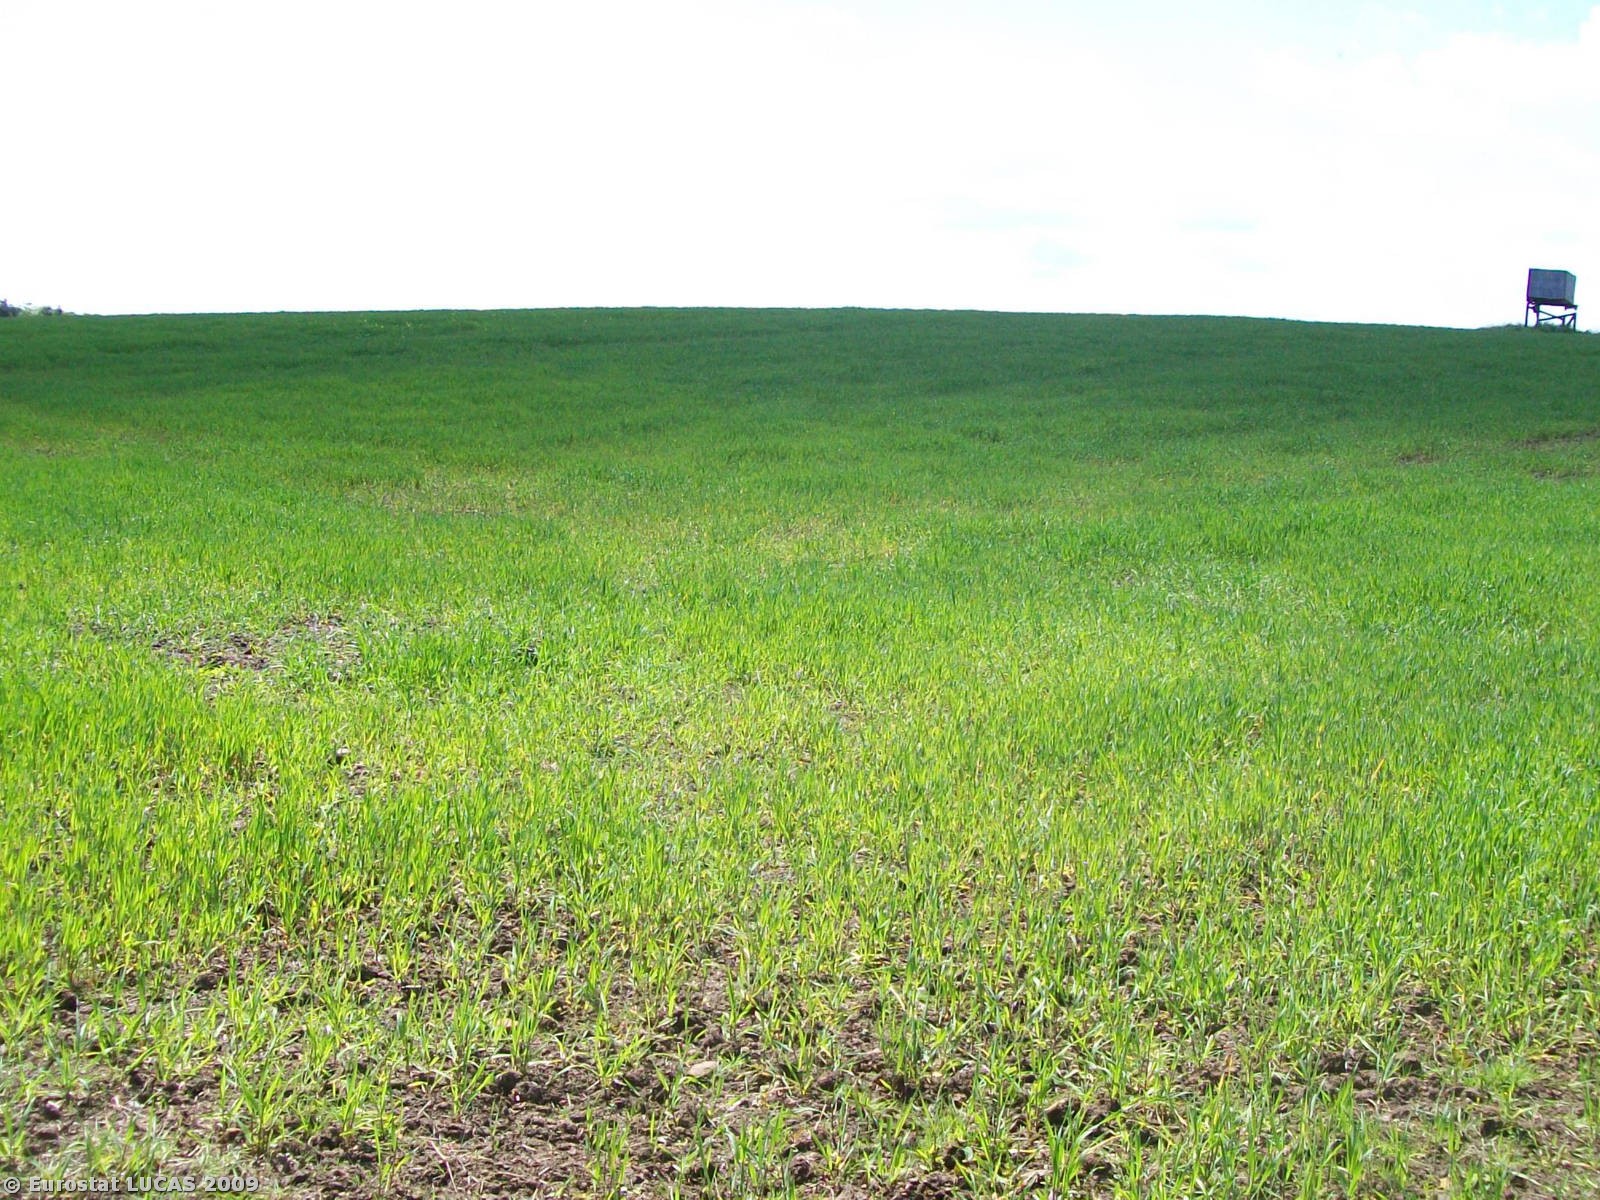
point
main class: Cropland
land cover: Common wheat
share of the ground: < 10 %
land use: Agriculture (excluding fallow land and kitchen gardens)
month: June
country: GB
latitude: 54.4565
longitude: -1.6346
